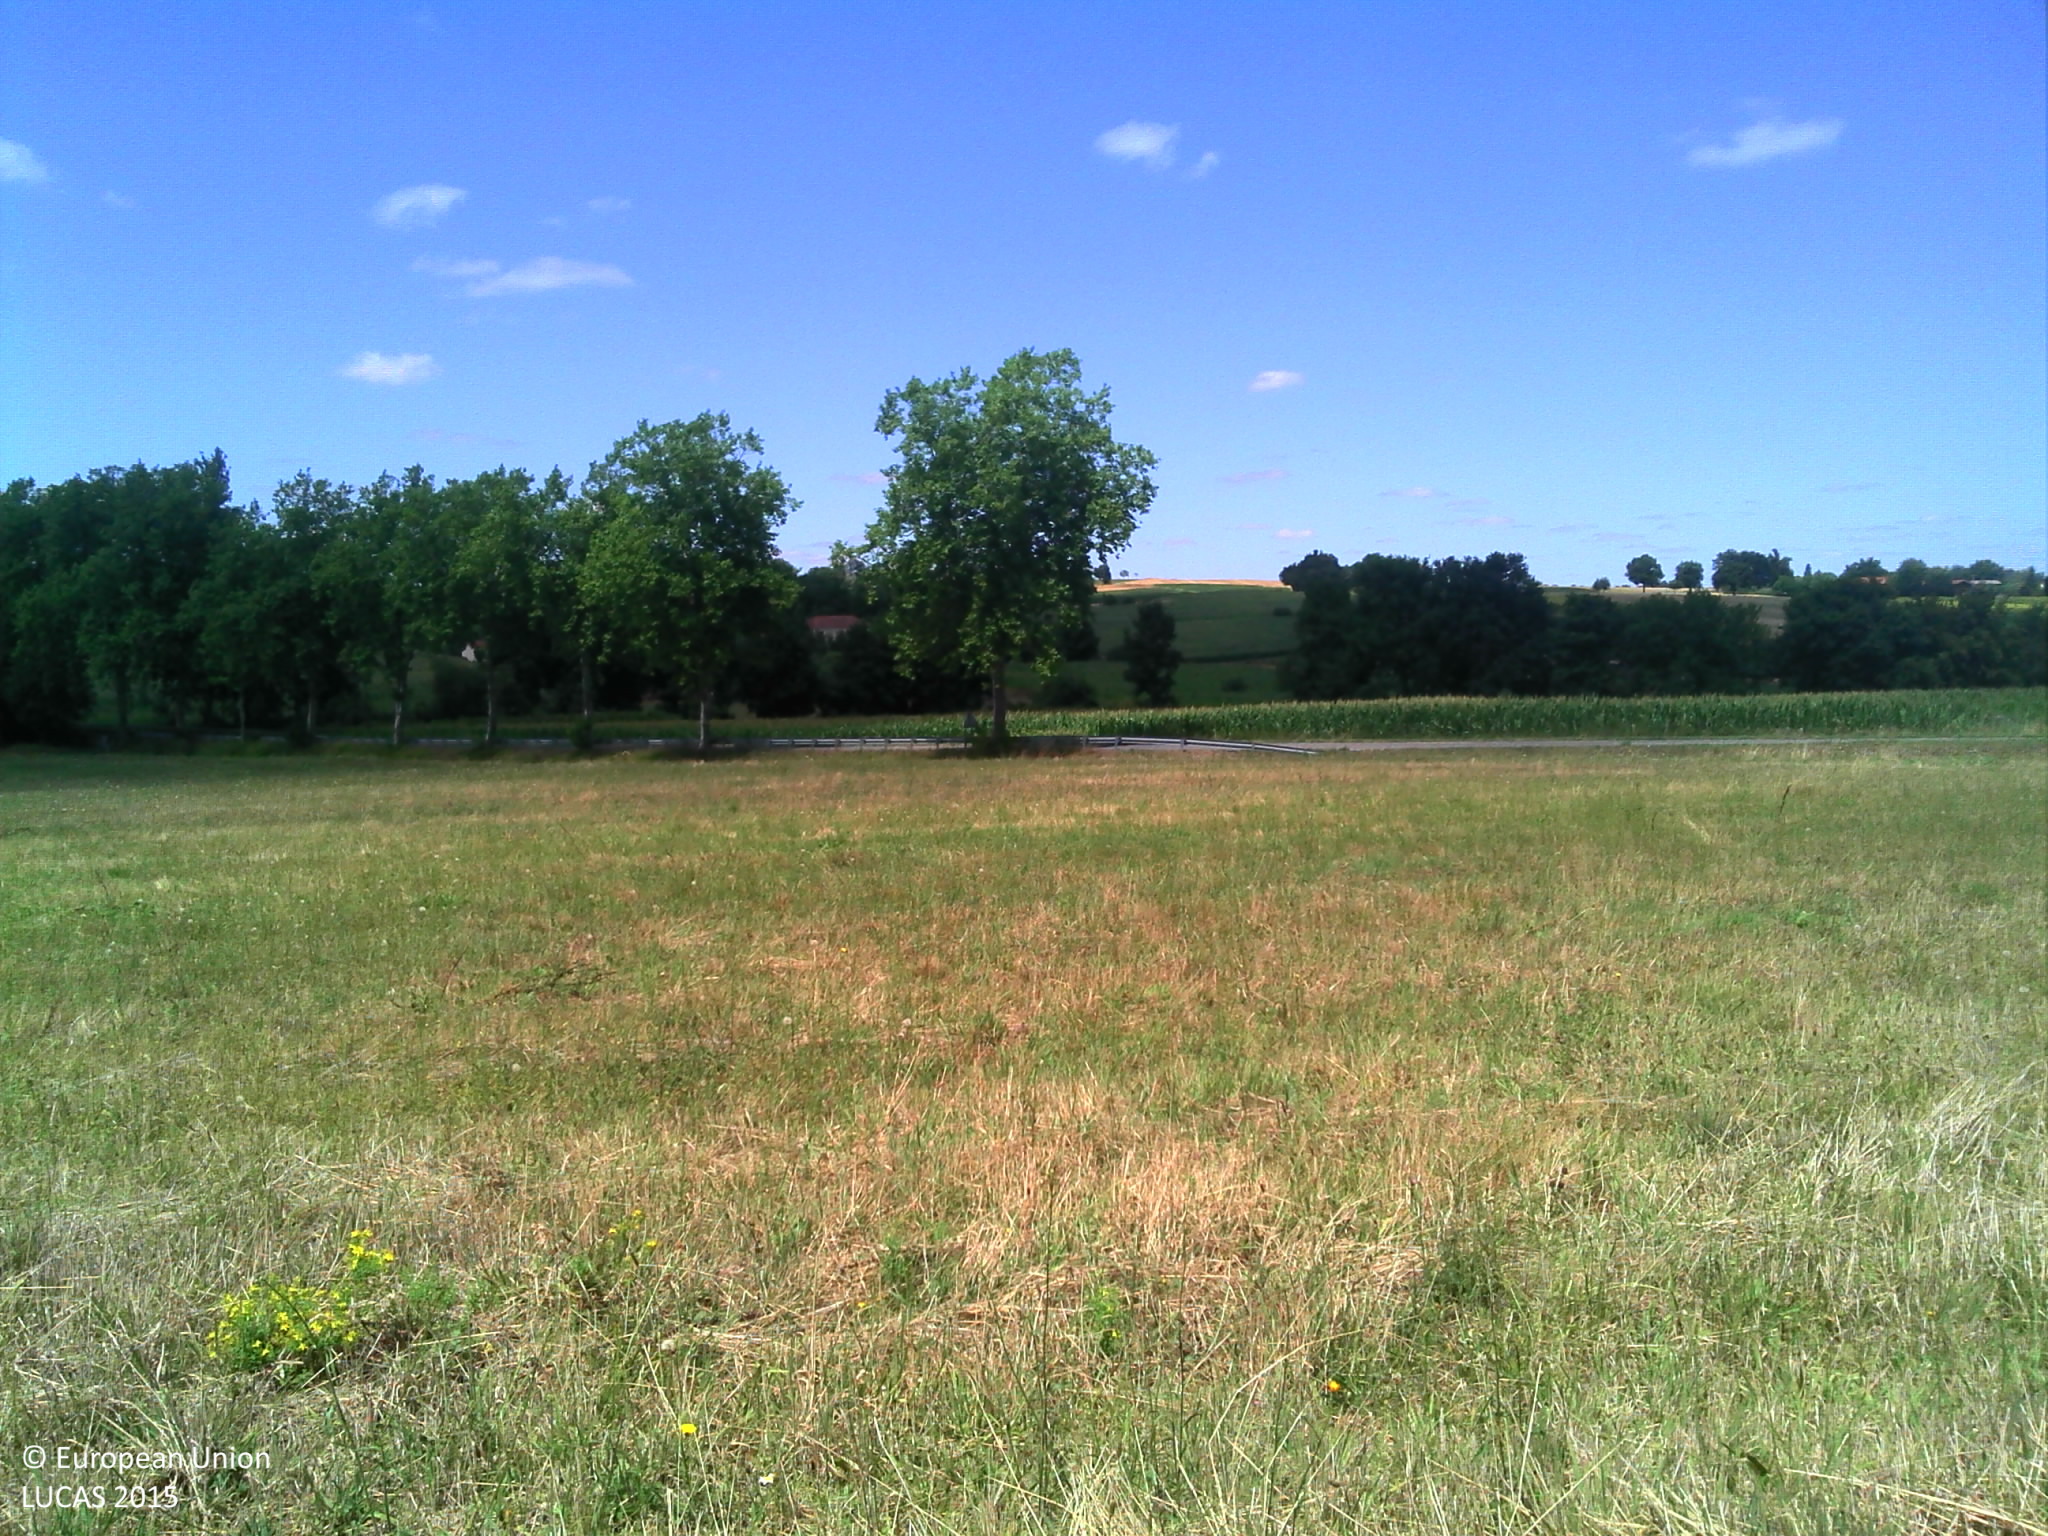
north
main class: Grassland
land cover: Grassland without tree/shrub cover
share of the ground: > 75 %
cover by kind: herbaceous plants 100 %
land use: Agriculture (excluding fallow land and kitchen gardens)
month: July
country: FR
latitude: 43.2471
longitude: 0.7517
